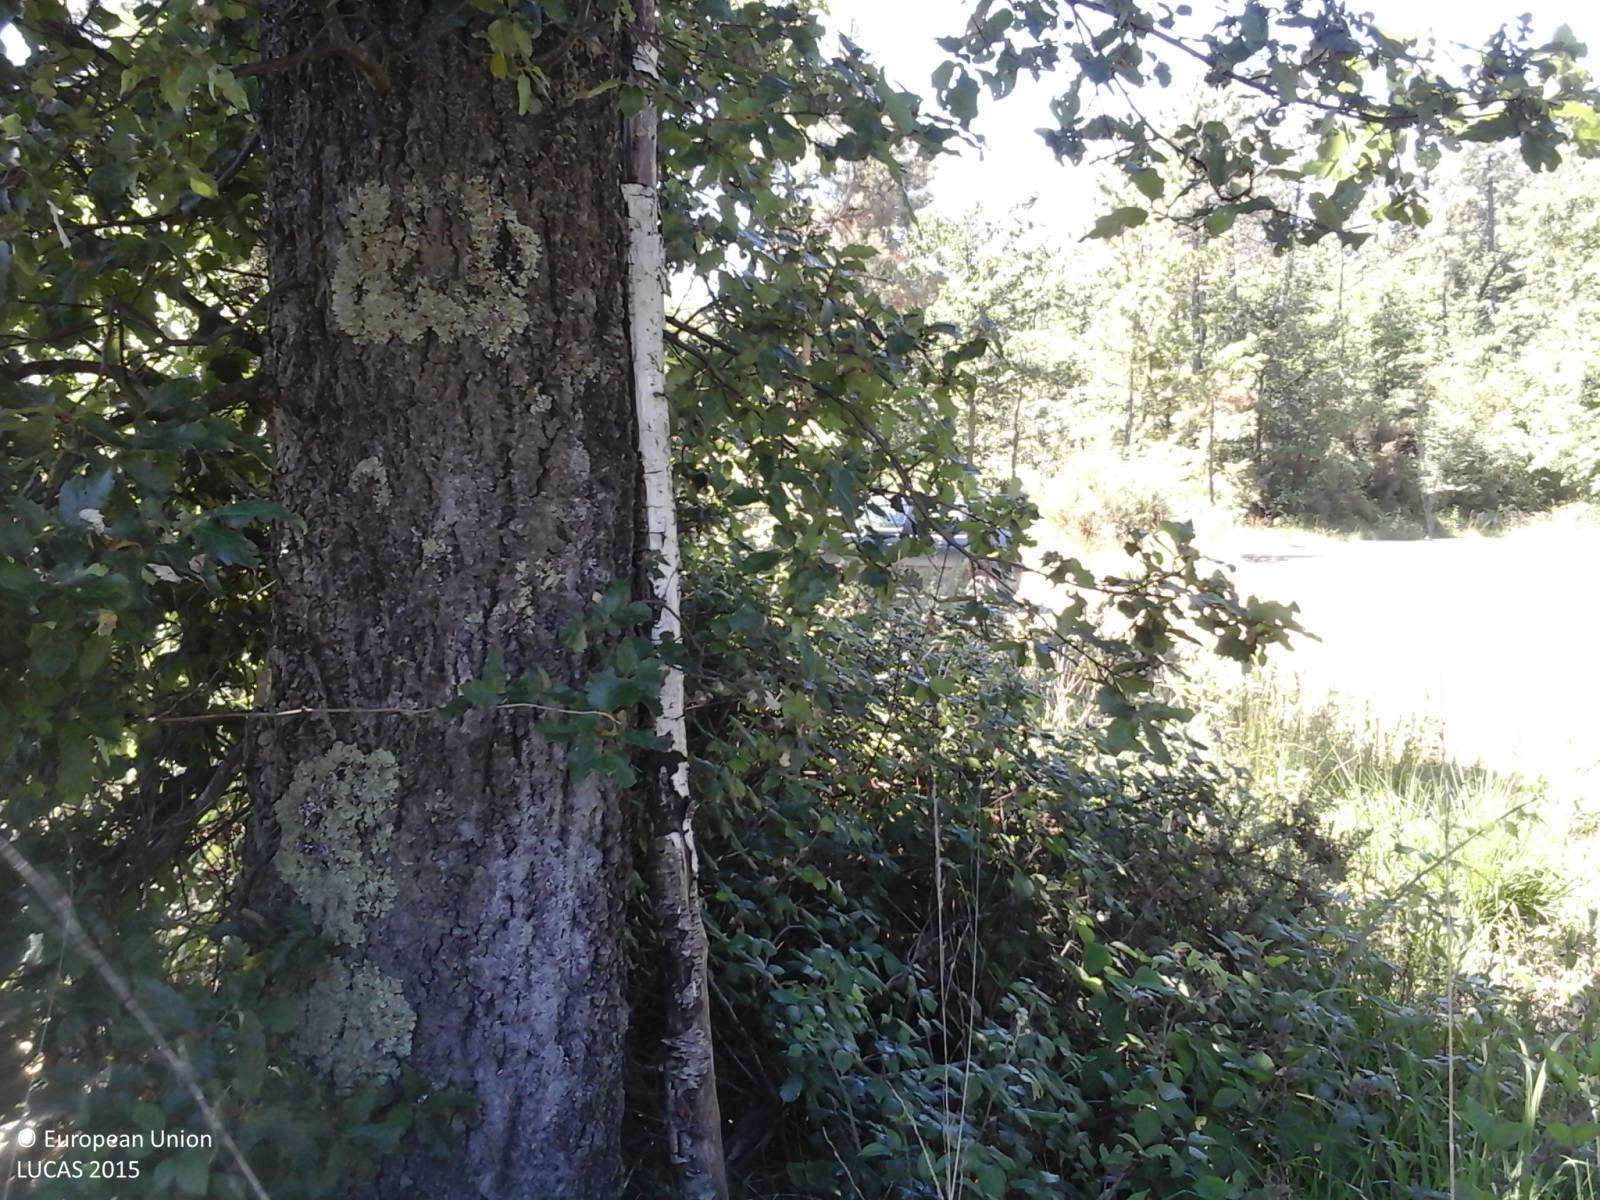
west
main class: Woodland
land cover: Broadleaved woodland
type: thermophilous deciduous forest
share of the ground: > 75 %
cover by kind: broadleaved forest trees 80 %, coniferous forest trees 10 %, shrubs 10 %
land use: Semi-natural and natural areas not in use
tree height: > 5 m
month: June
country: IT
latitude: 44.2062
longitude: 9.9126
